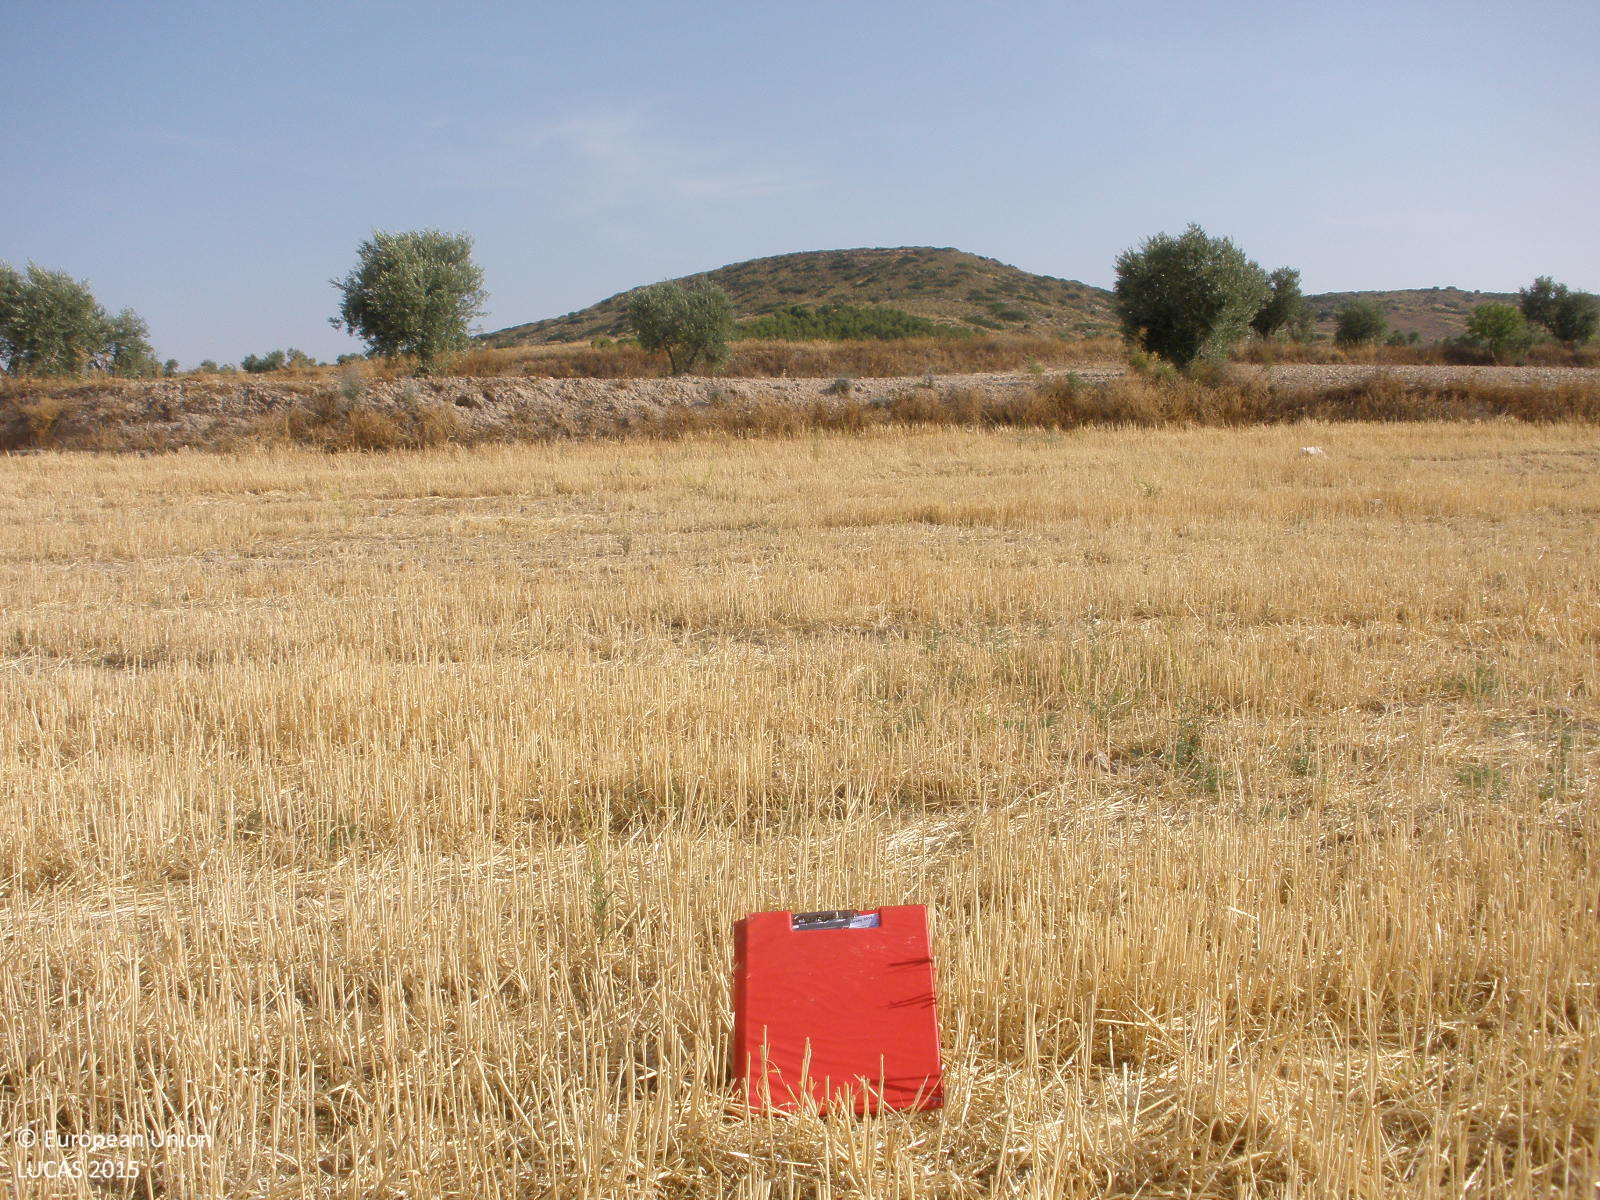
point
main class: Cropland
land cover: Barley
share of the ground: < 10 %
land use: Agriculture (excluding fallow land and kitchen gardens)
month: July
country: ES
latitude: 40.1040
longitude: -3.4624
